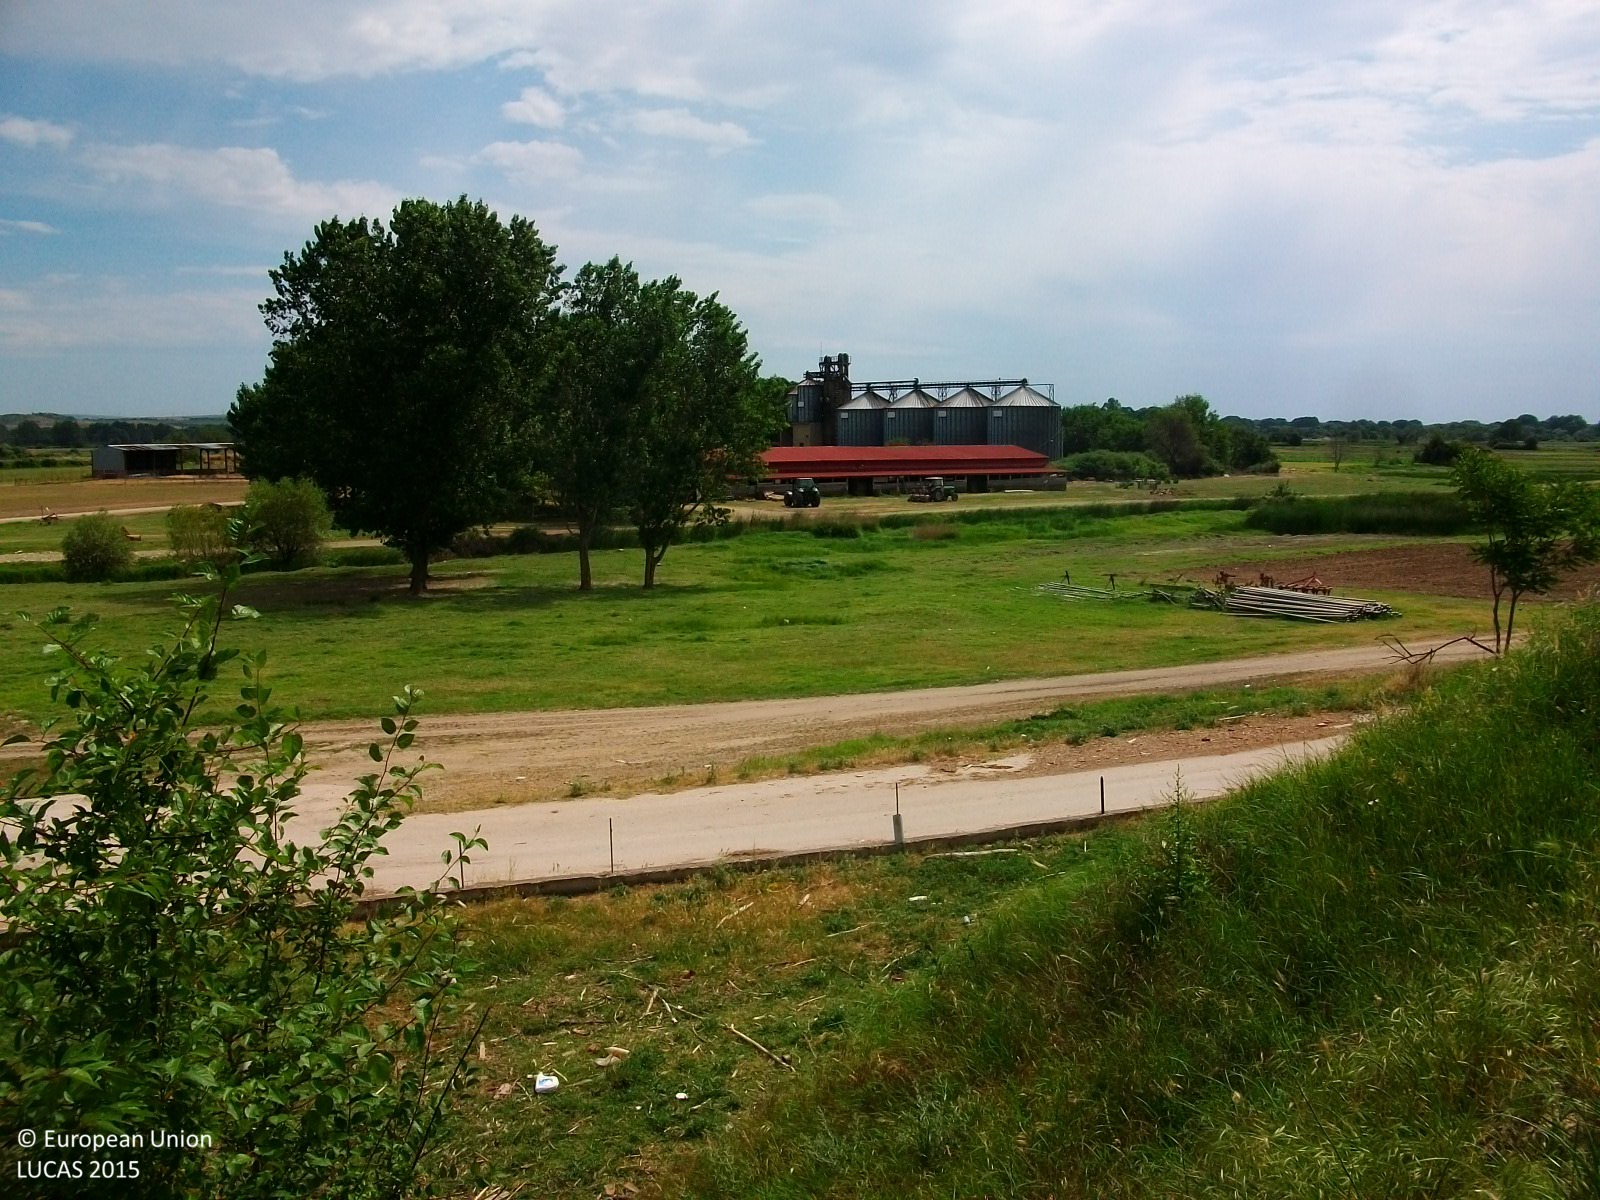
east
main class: Grassland
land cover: Grassland with sparse tree/shrub cover
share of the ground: > 75 %
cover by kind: herbaceous plants 90 %, broadleaved forest trees 5 %, shrubs 5 %
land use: Abandoned areas
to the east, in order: Grassland with sparse tree/shrub cover; Artificial constructions; Paved roads, cycling and walking lanes; Spontaneously vegetated surfaces; Tracks; Grassland without tree/shrub cover; Ditches and canals; Inland marshes; Inland fresh running water; Inland marshes; Grass margins; Tracks; Spontaneously vegetated surfaces
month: June
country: GR
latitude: 41.7226
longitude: 26.2194
